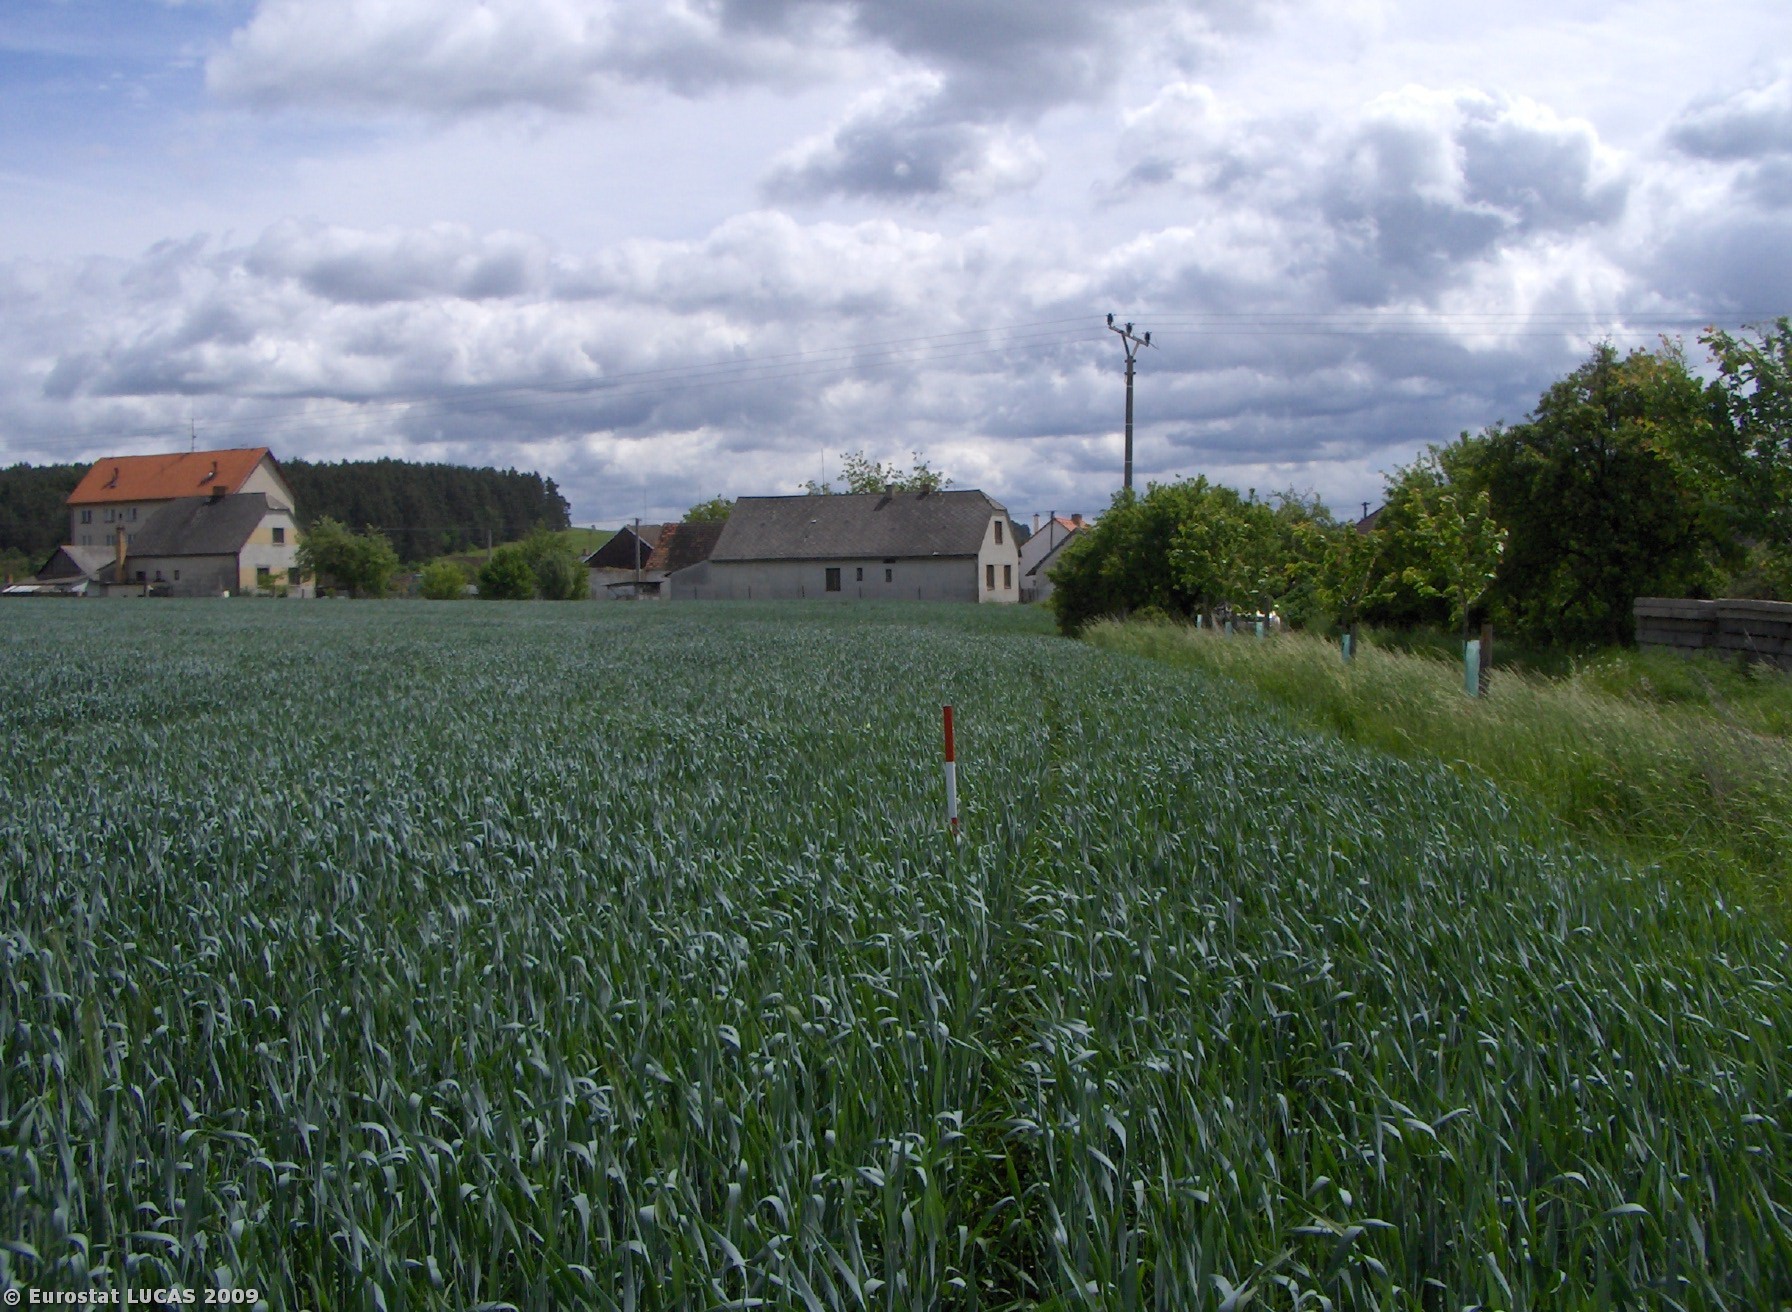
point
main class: Cropland
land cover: Common wheat
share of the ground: > 75 %
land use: Agriculture (excluding fallow land and kitchen gardens)
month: May
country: CZ
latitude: 49.3274
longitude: 14.3353
